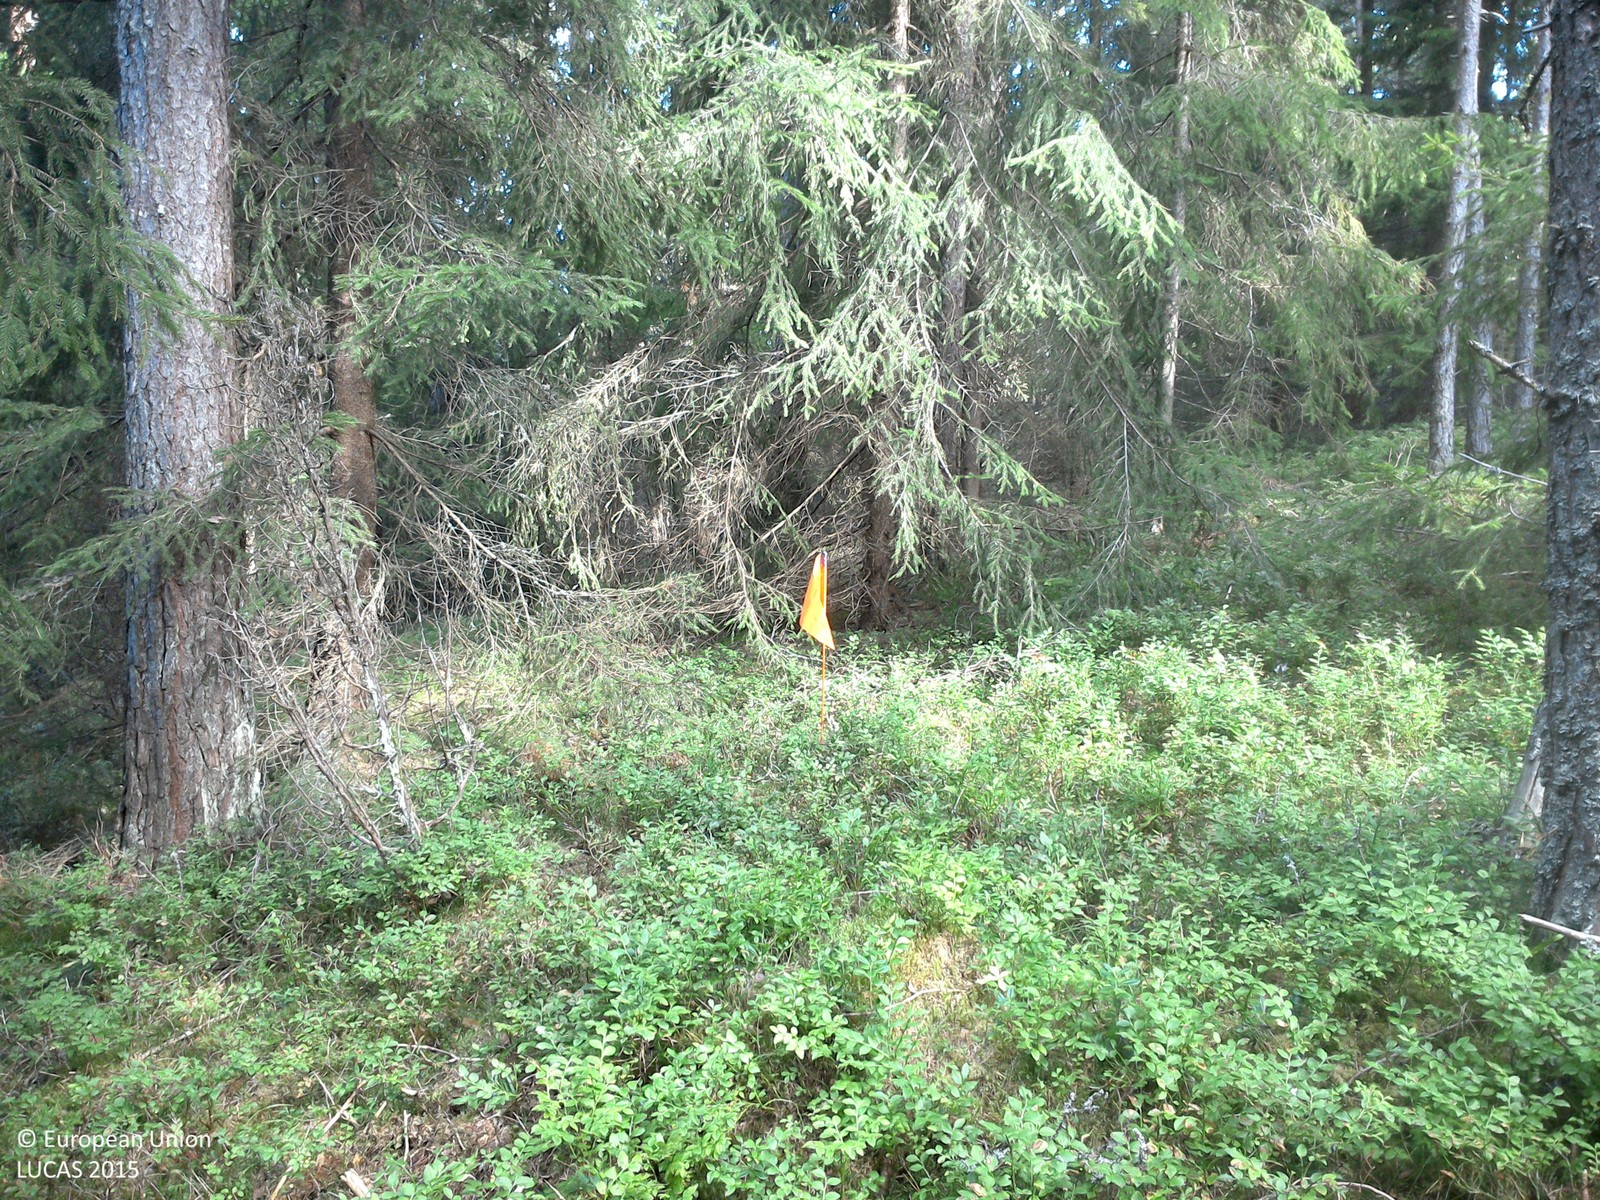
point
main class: Woodland
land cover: Spruce dominated coniferous woodland
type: boreal forest
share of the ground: 25 - 50 %
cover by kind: coniferous forest trees 50 %, herbaceous plants 30 %, lichens and mosses 20 %
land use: Forestry
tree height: > 5 m
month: August
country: SE
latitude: 57.9010
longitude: 15.2428
